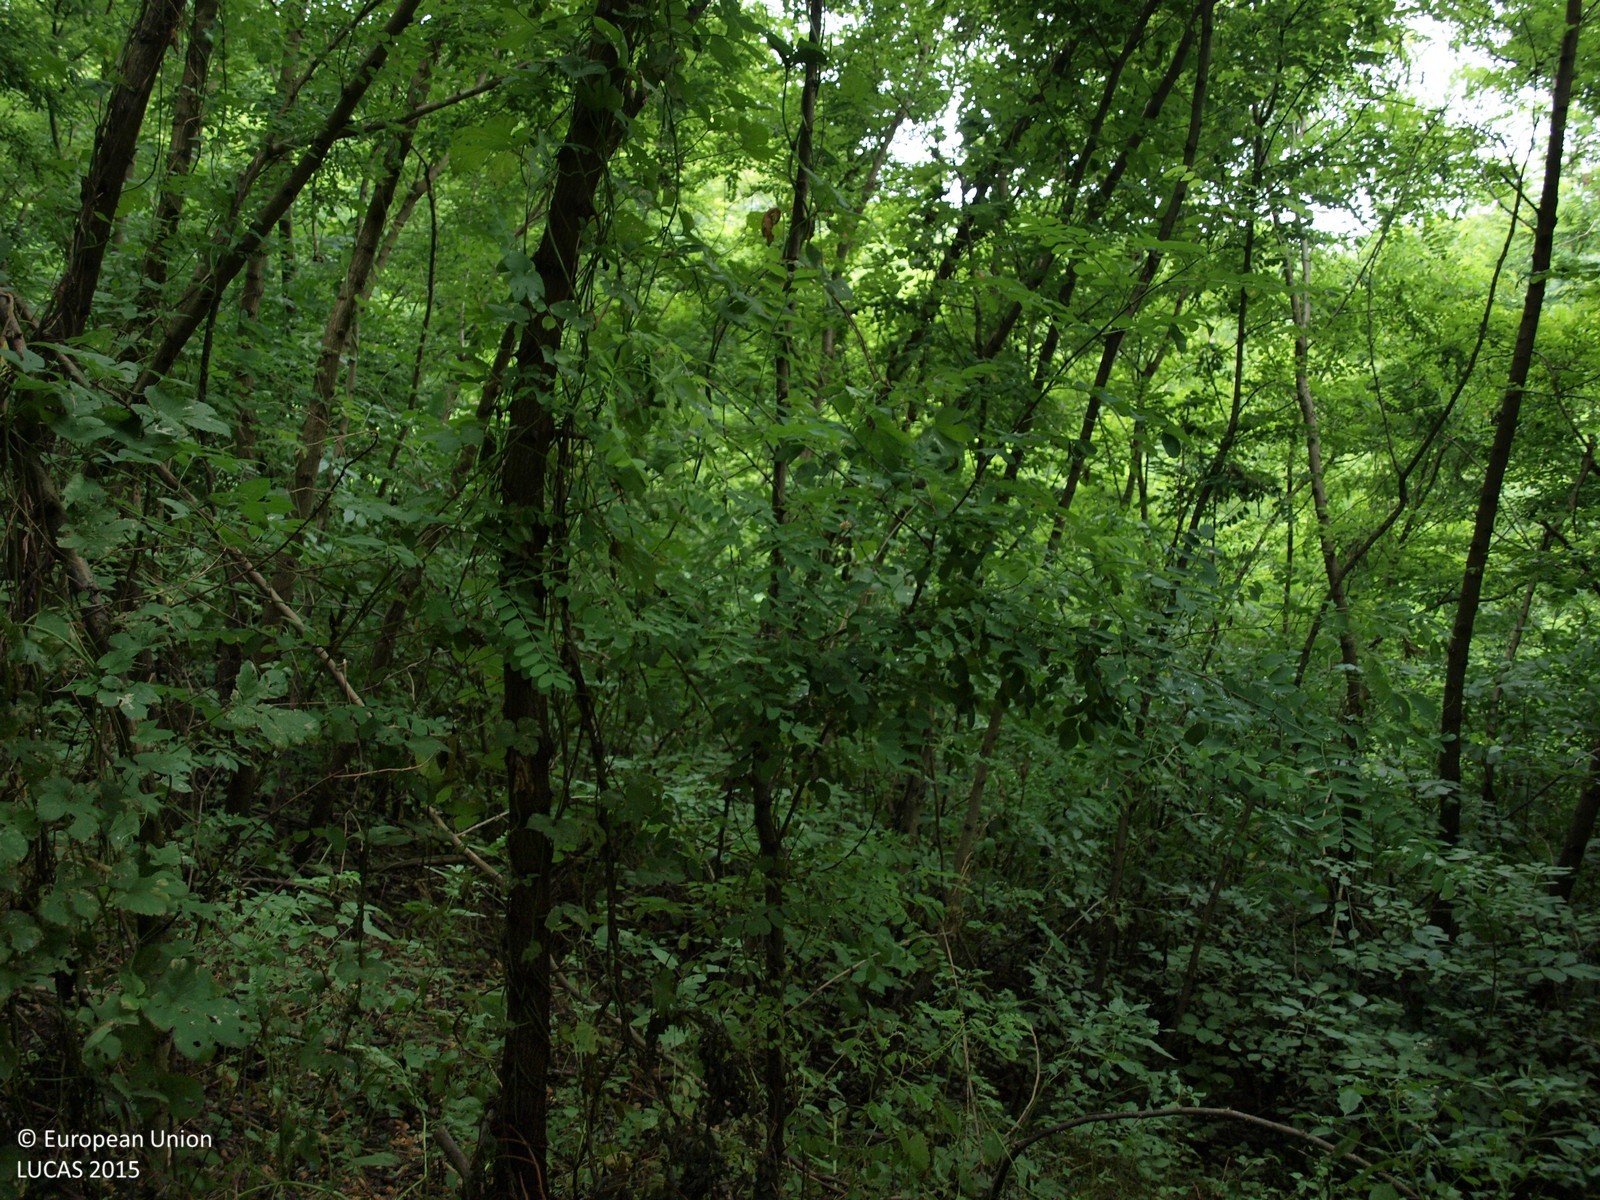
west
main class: Woodland
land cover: Broadleaved woodland
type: mesophytic deciduous forest
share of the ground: > 75 %
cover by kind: broadleaved forest trees 100 %
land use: Forestry
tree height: > 5 m
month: July
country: HR
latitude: 46.0364
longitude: 16.3436
